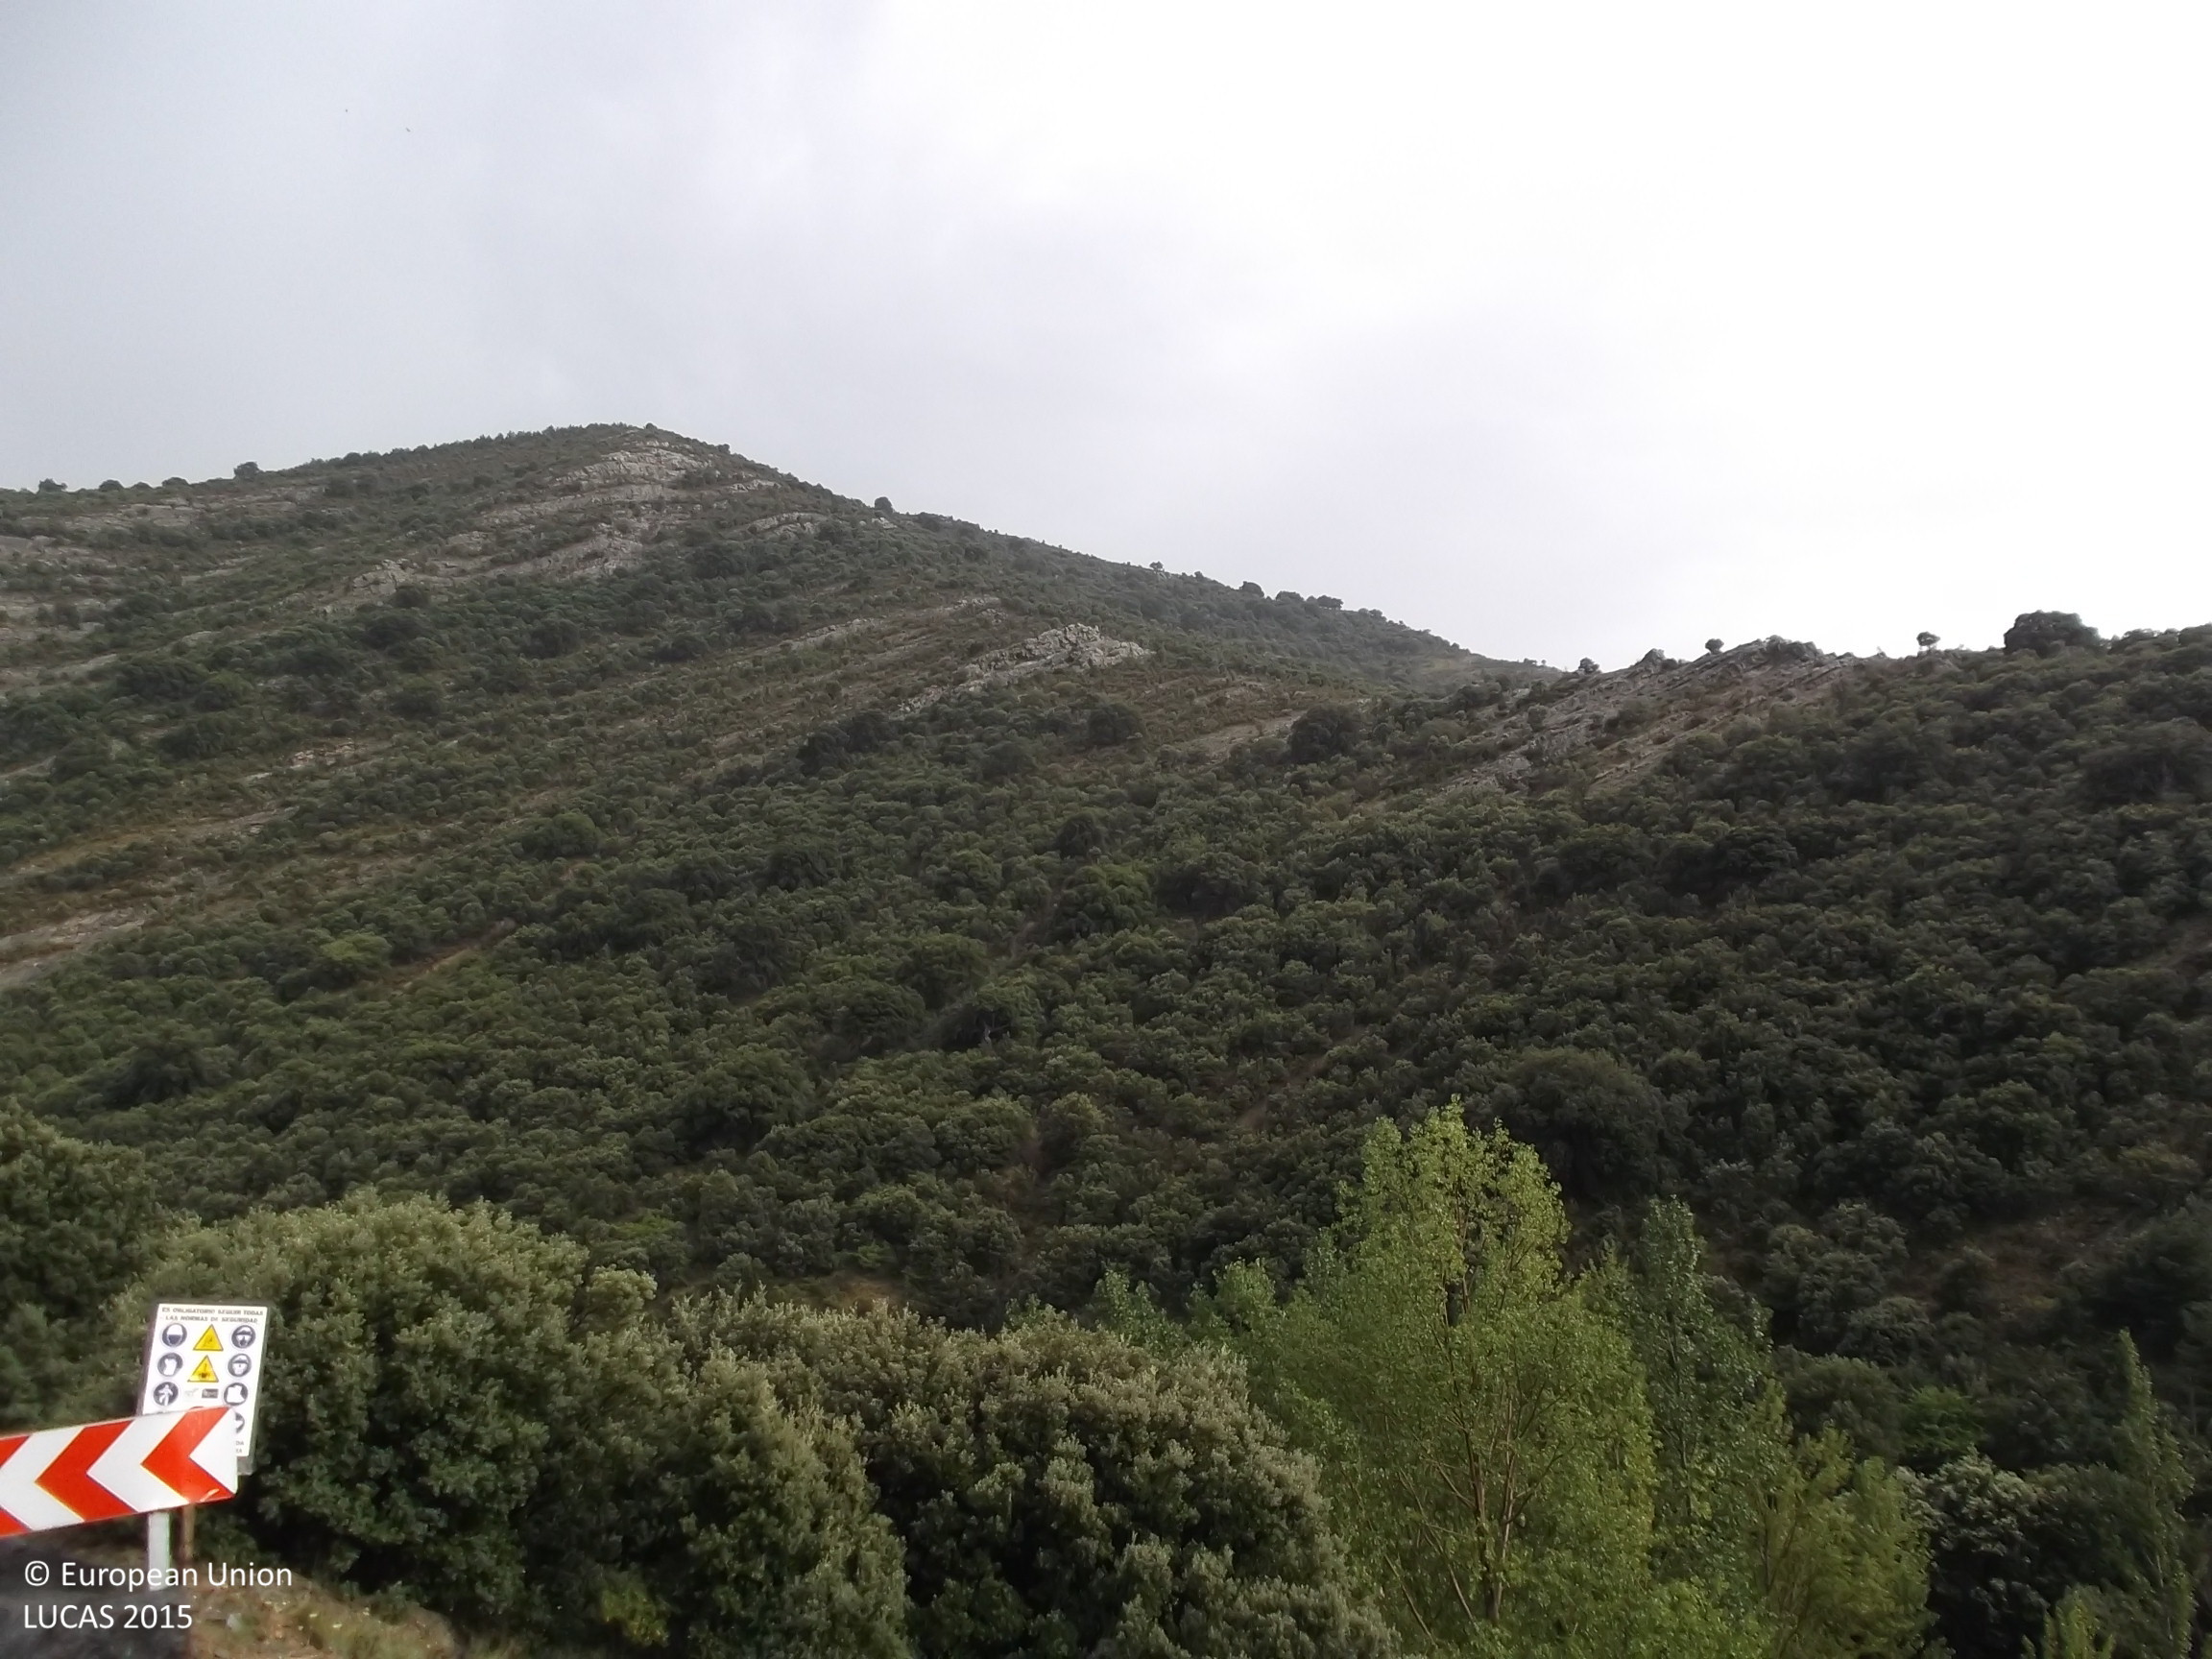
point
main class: Woodland
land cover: Broadleaved woodland
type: broadleaved evergreen forest
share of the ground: 10 - 25 %
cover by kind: shrubs 45 %, unconsolidated bare surface 30 %, broadleaved forest trees 15 %
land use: Semi-natural and natural areas not in use
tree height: > 5 m
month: July
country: ES
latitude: 42.1212
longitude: -2.2926
